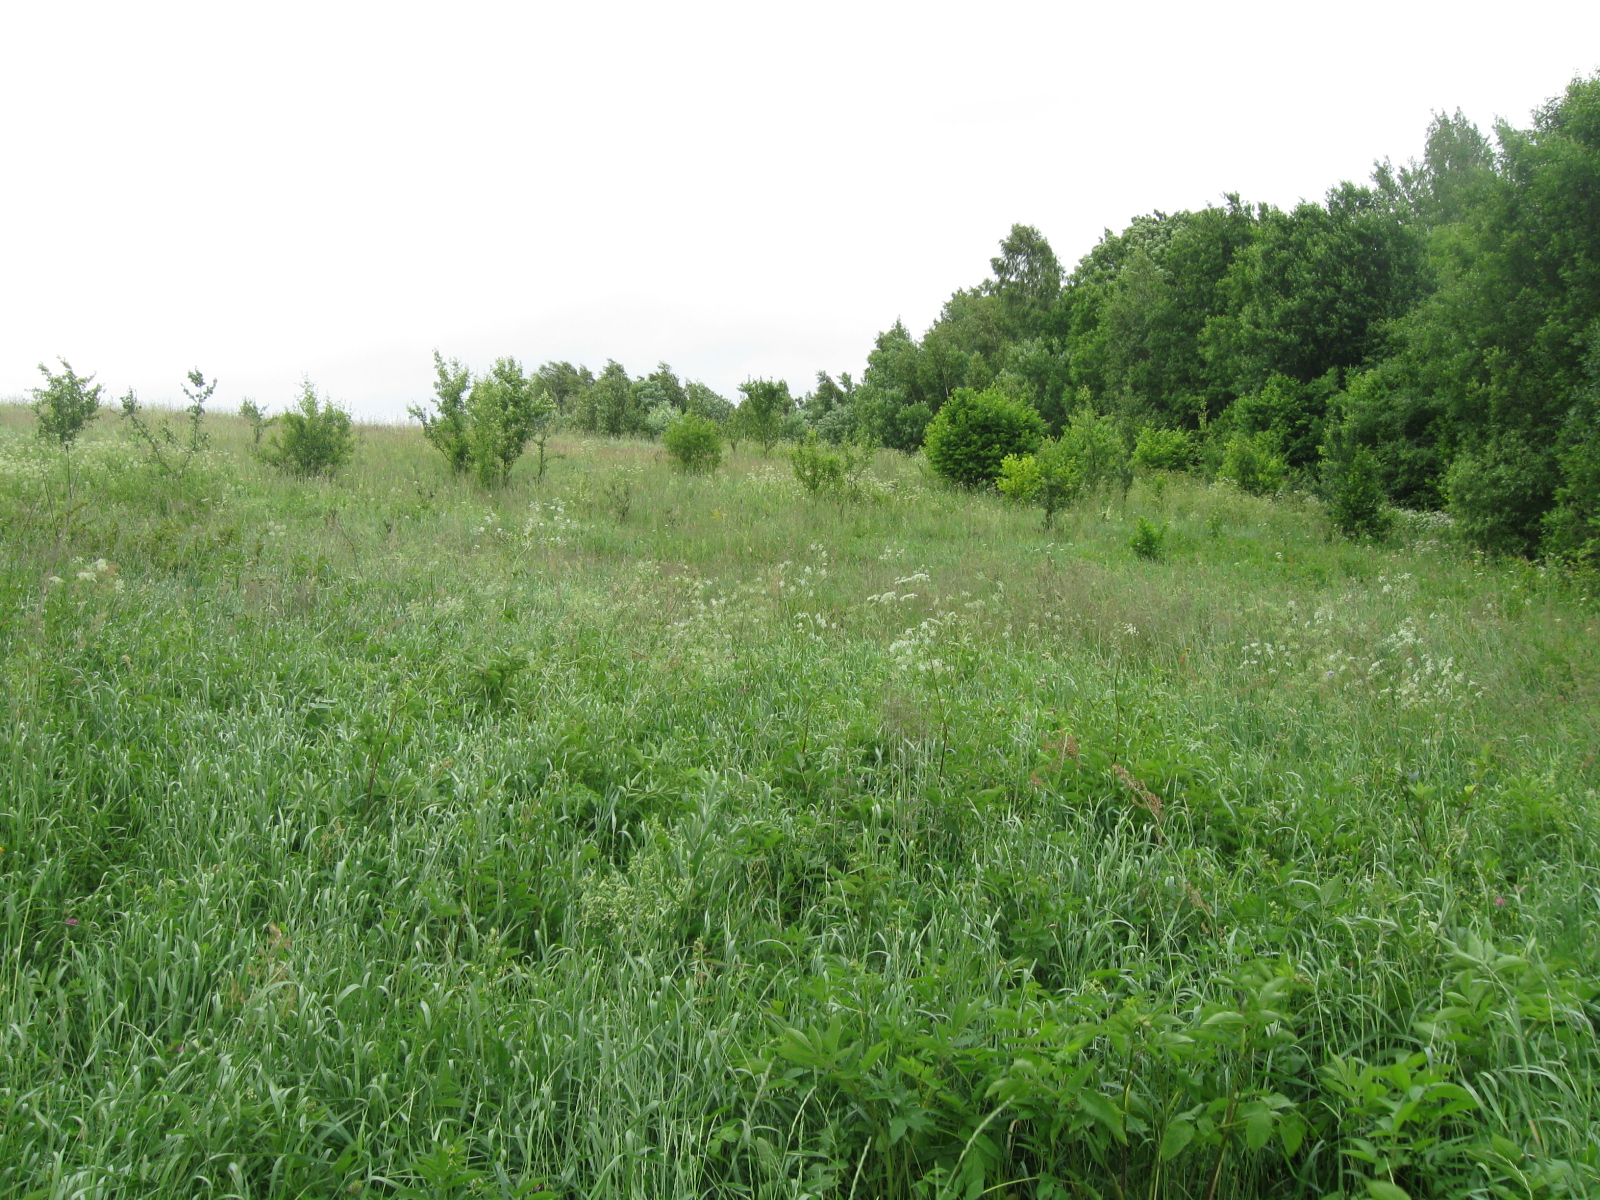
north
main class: Grassland
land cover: Grassland with sparse tree/shrub cover
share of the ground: > 75 %
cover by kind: herbaceous plants 90 %, broadleaved forest trees 5 %, shrubs 5 %
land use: Agriculture (excluding fallow land and kitchen gardens)
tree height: < 5 m
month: June
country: LT
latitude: 54.6236
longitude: 24.3643
